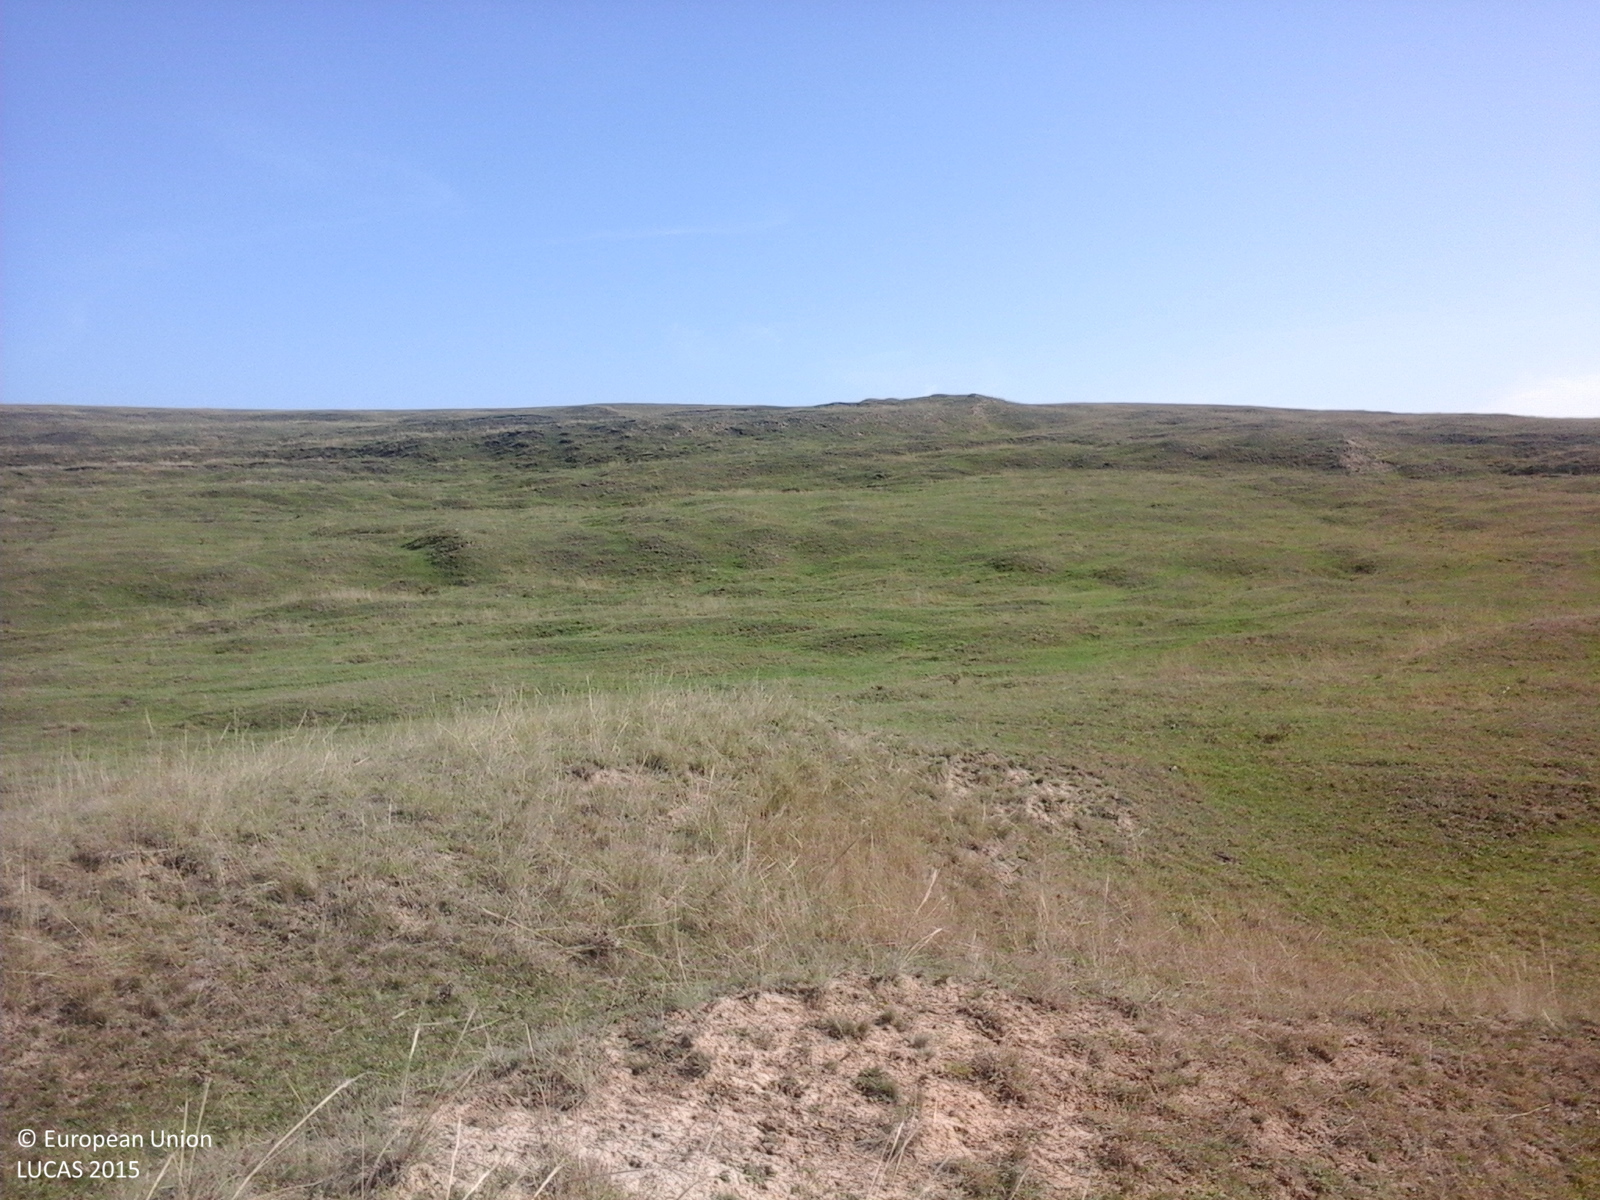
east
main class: Grassland
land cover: Grassland without tree/shrub cover
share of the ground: > 75 %
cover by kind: herbaceous plants 100 %
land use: Agriculture (excluding fallow land and kitchen gardens)
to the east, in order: Grassland without tree/shrub cover
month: October
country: RO
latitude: 46.1623
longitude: 23.8114
